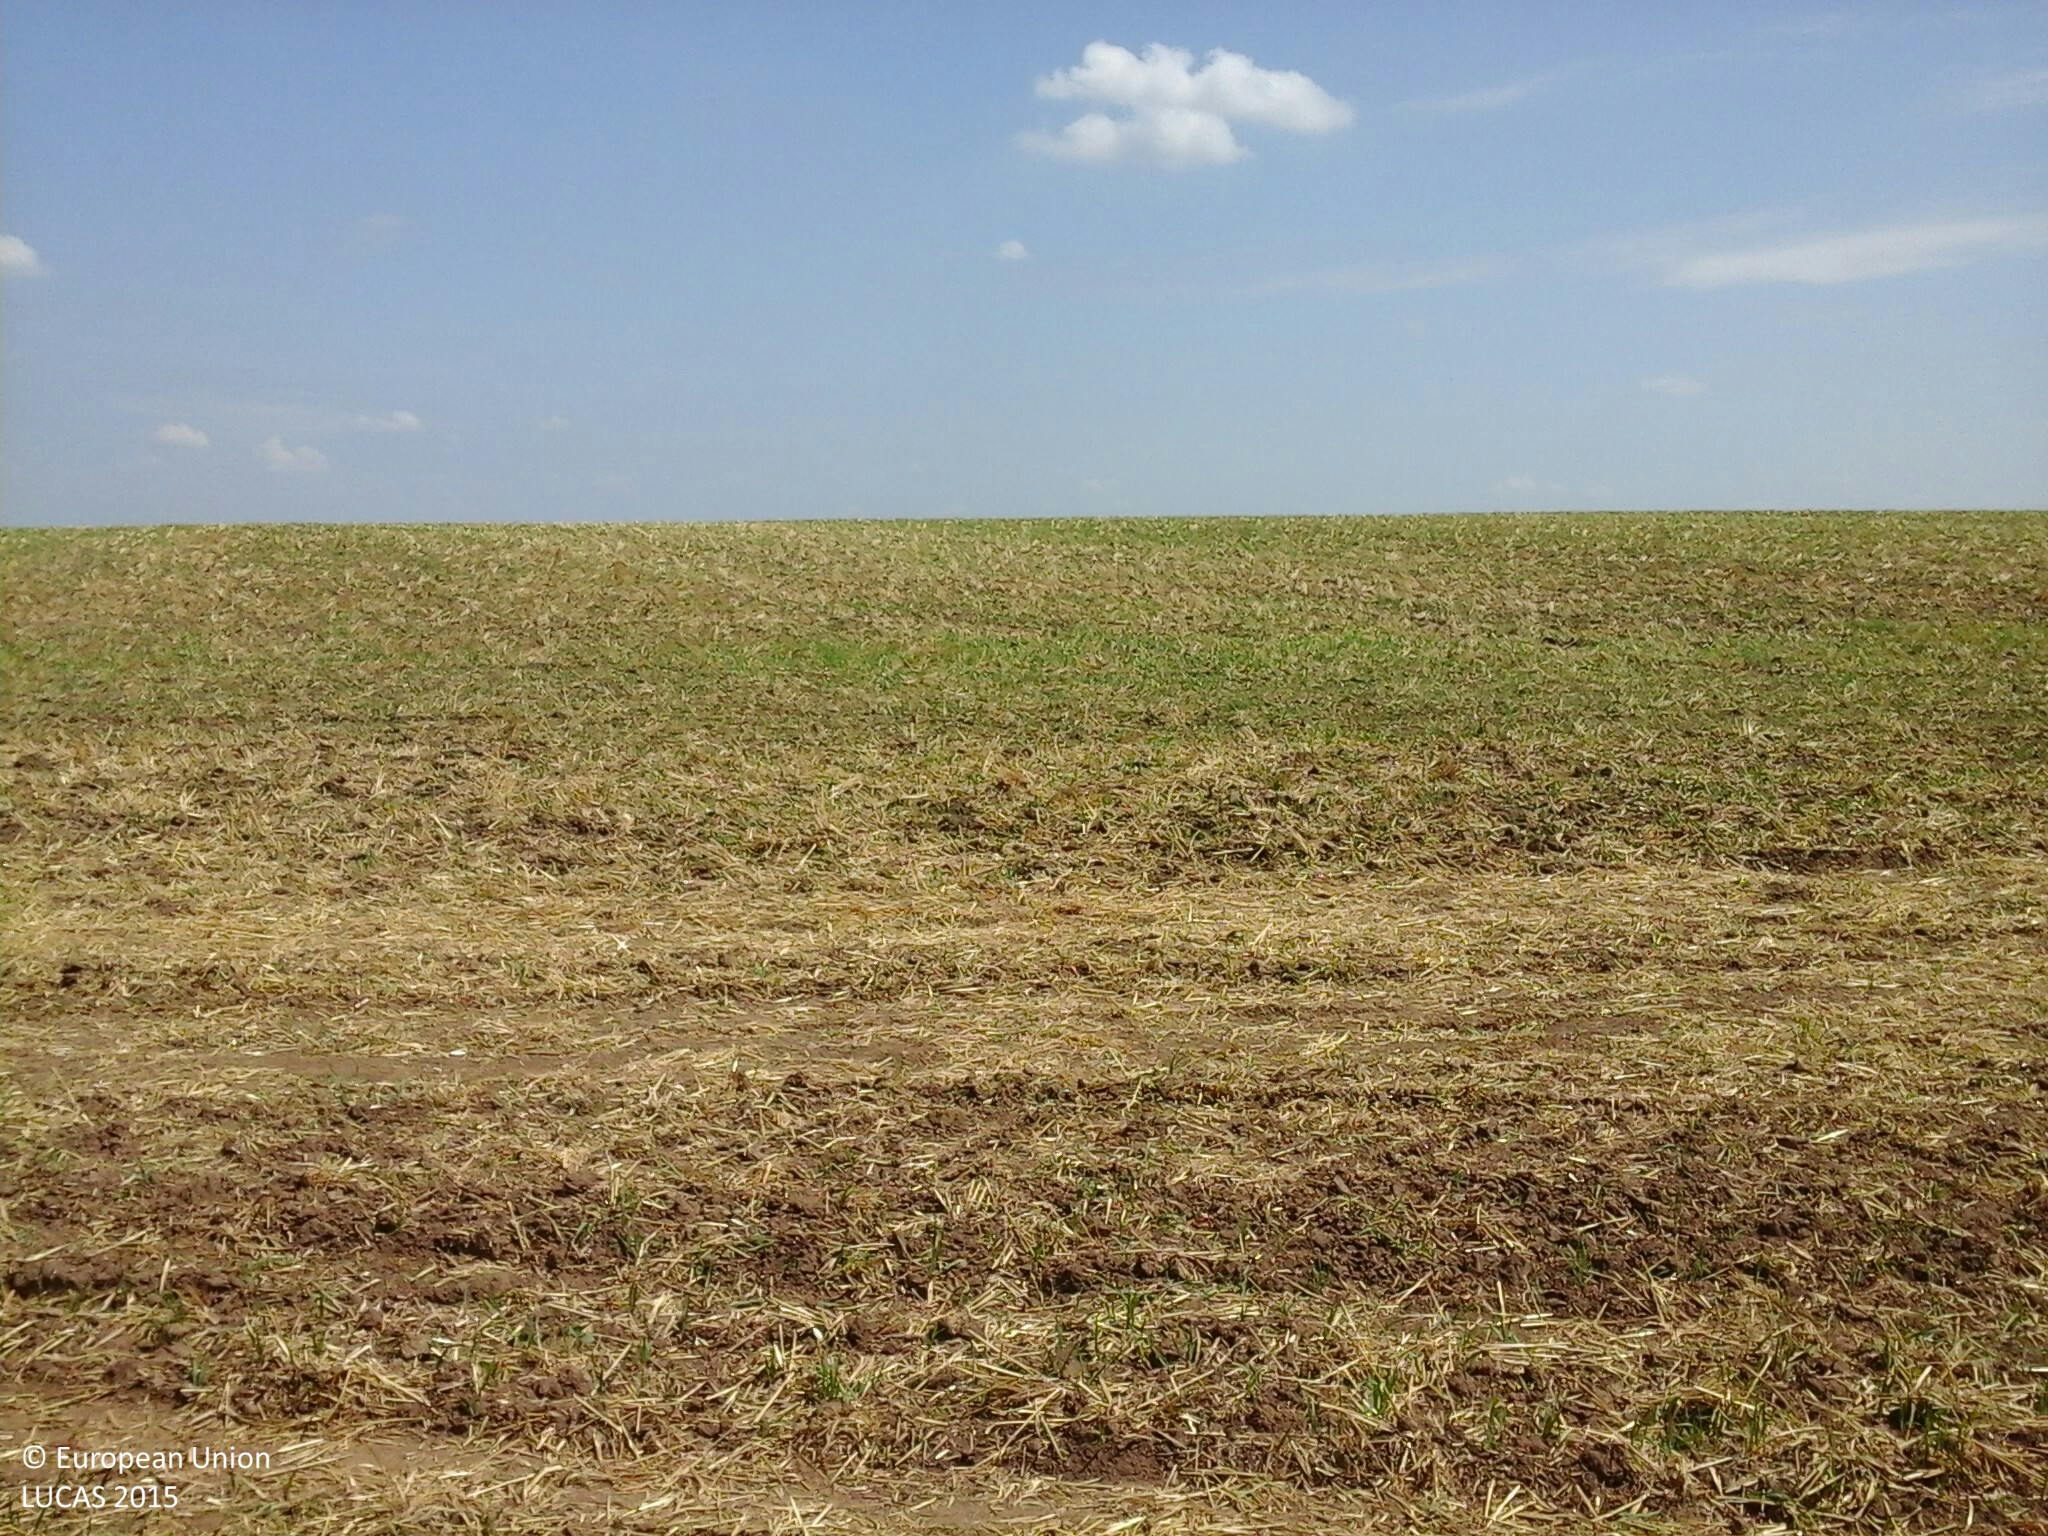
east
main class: Cropland
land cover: Common wheat
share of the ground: > 75 %
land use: Agriculture (excluding fallow land and kitchen gardens)
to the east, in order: Common wheat
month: August
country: HU
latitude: 46.8617
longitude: 18.0499
